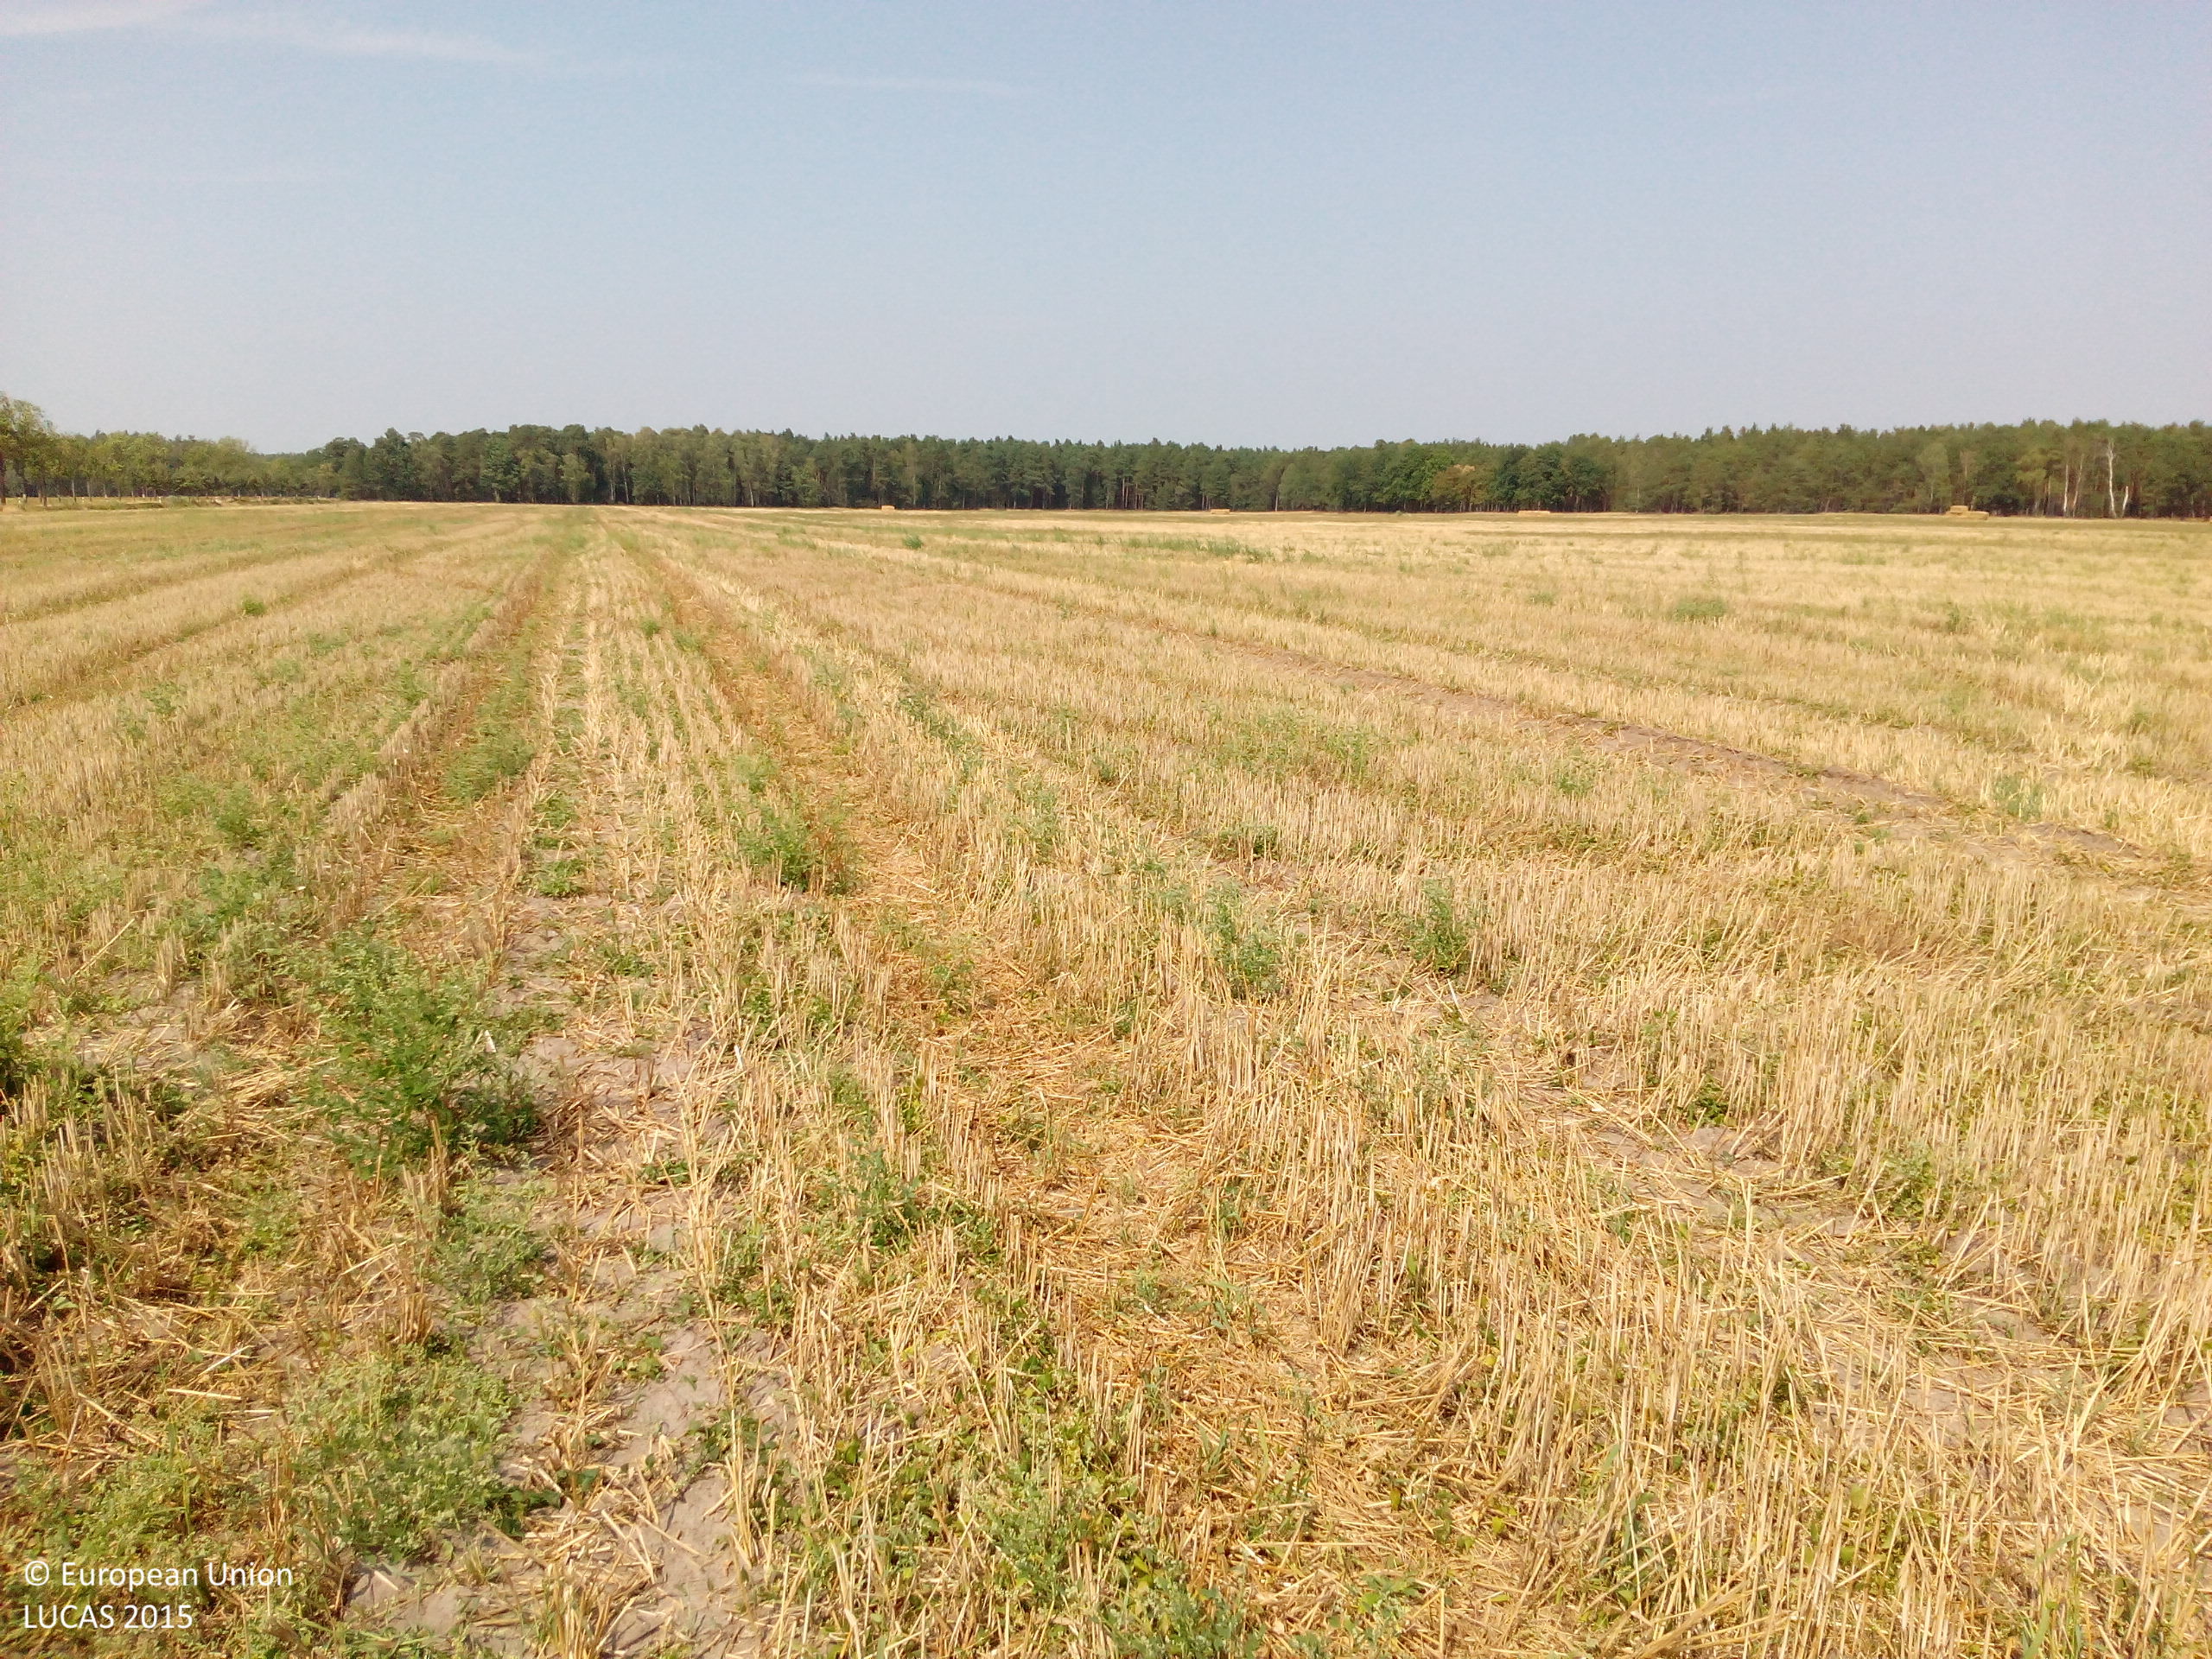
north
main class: Cropland
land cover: Rye
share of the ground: 10 - 25 %
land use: Agriculture (excluding fallow land and kitchen gardens)
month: August
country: DE
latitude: 51.8829
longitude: 14.3744
